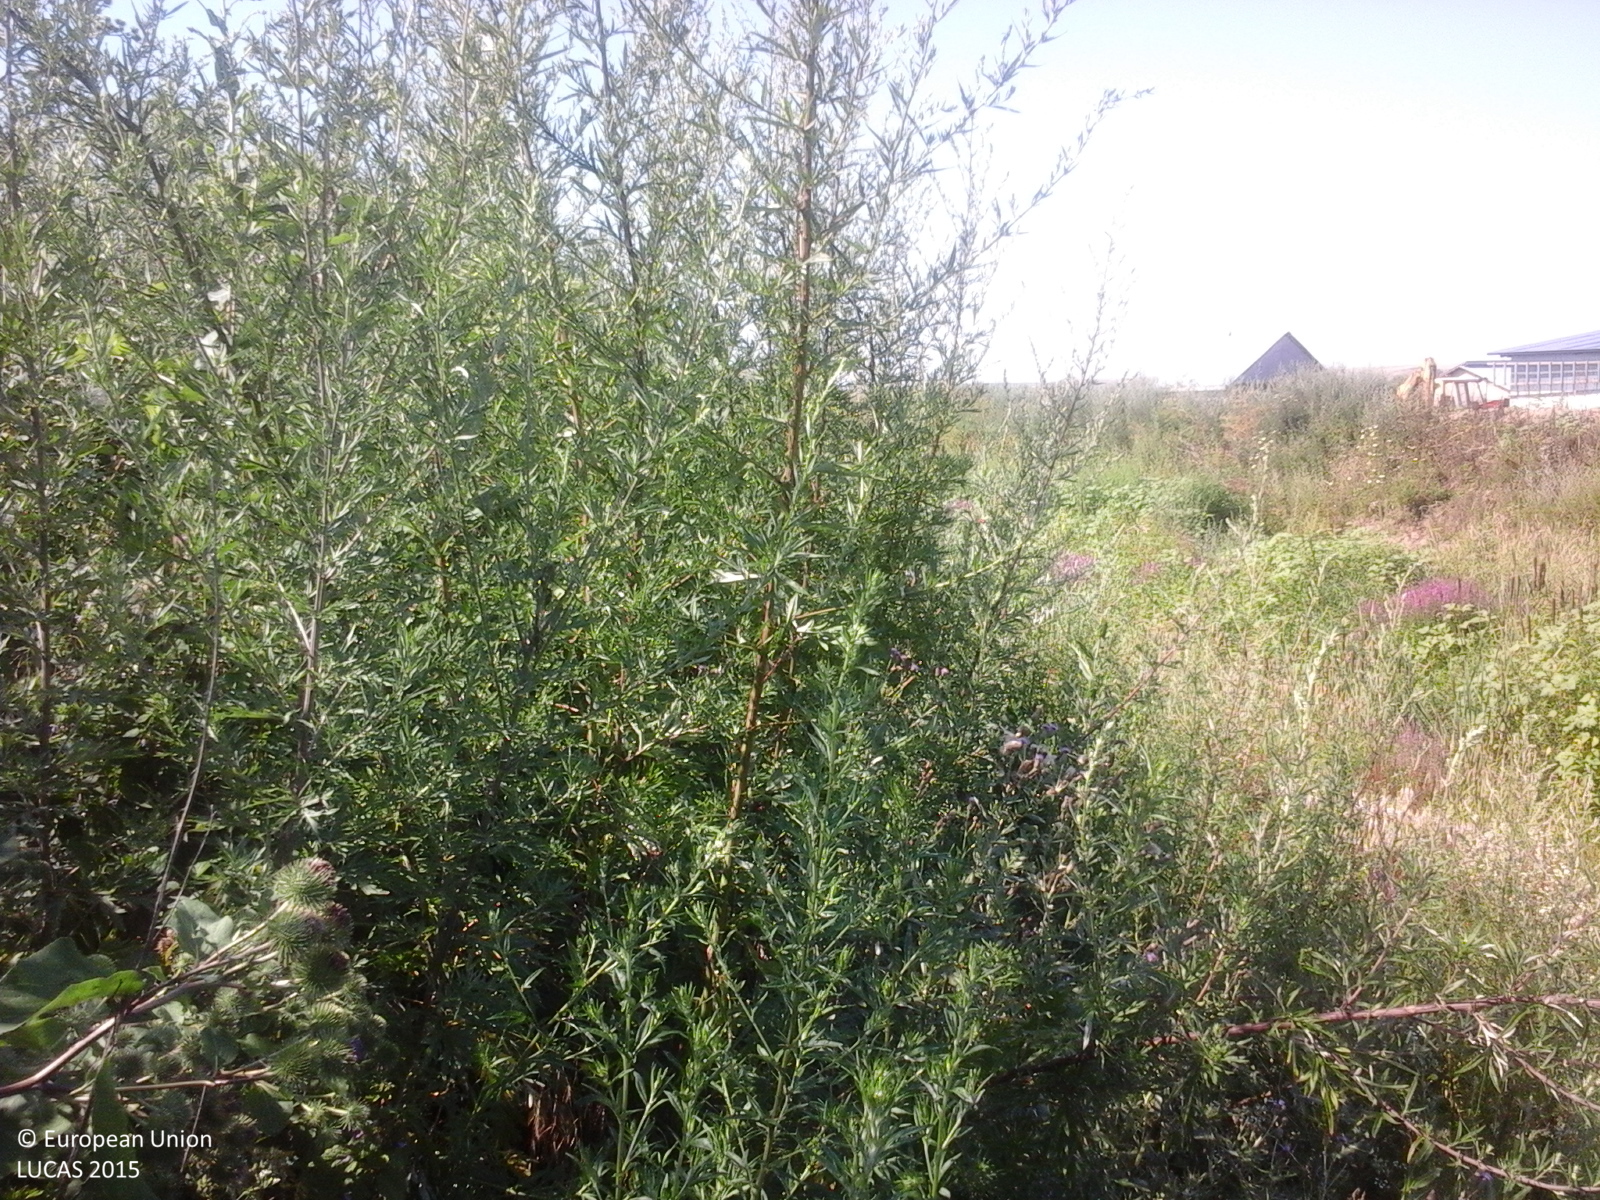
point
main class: Grassland
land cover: Spontaneously vegetated surfaces
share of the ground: > 75 %
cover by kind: herbaceous plants 100 %
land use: Semi-natural and natural areas not in use
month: July
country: RO
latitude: 44.3247
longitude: 24.5536
